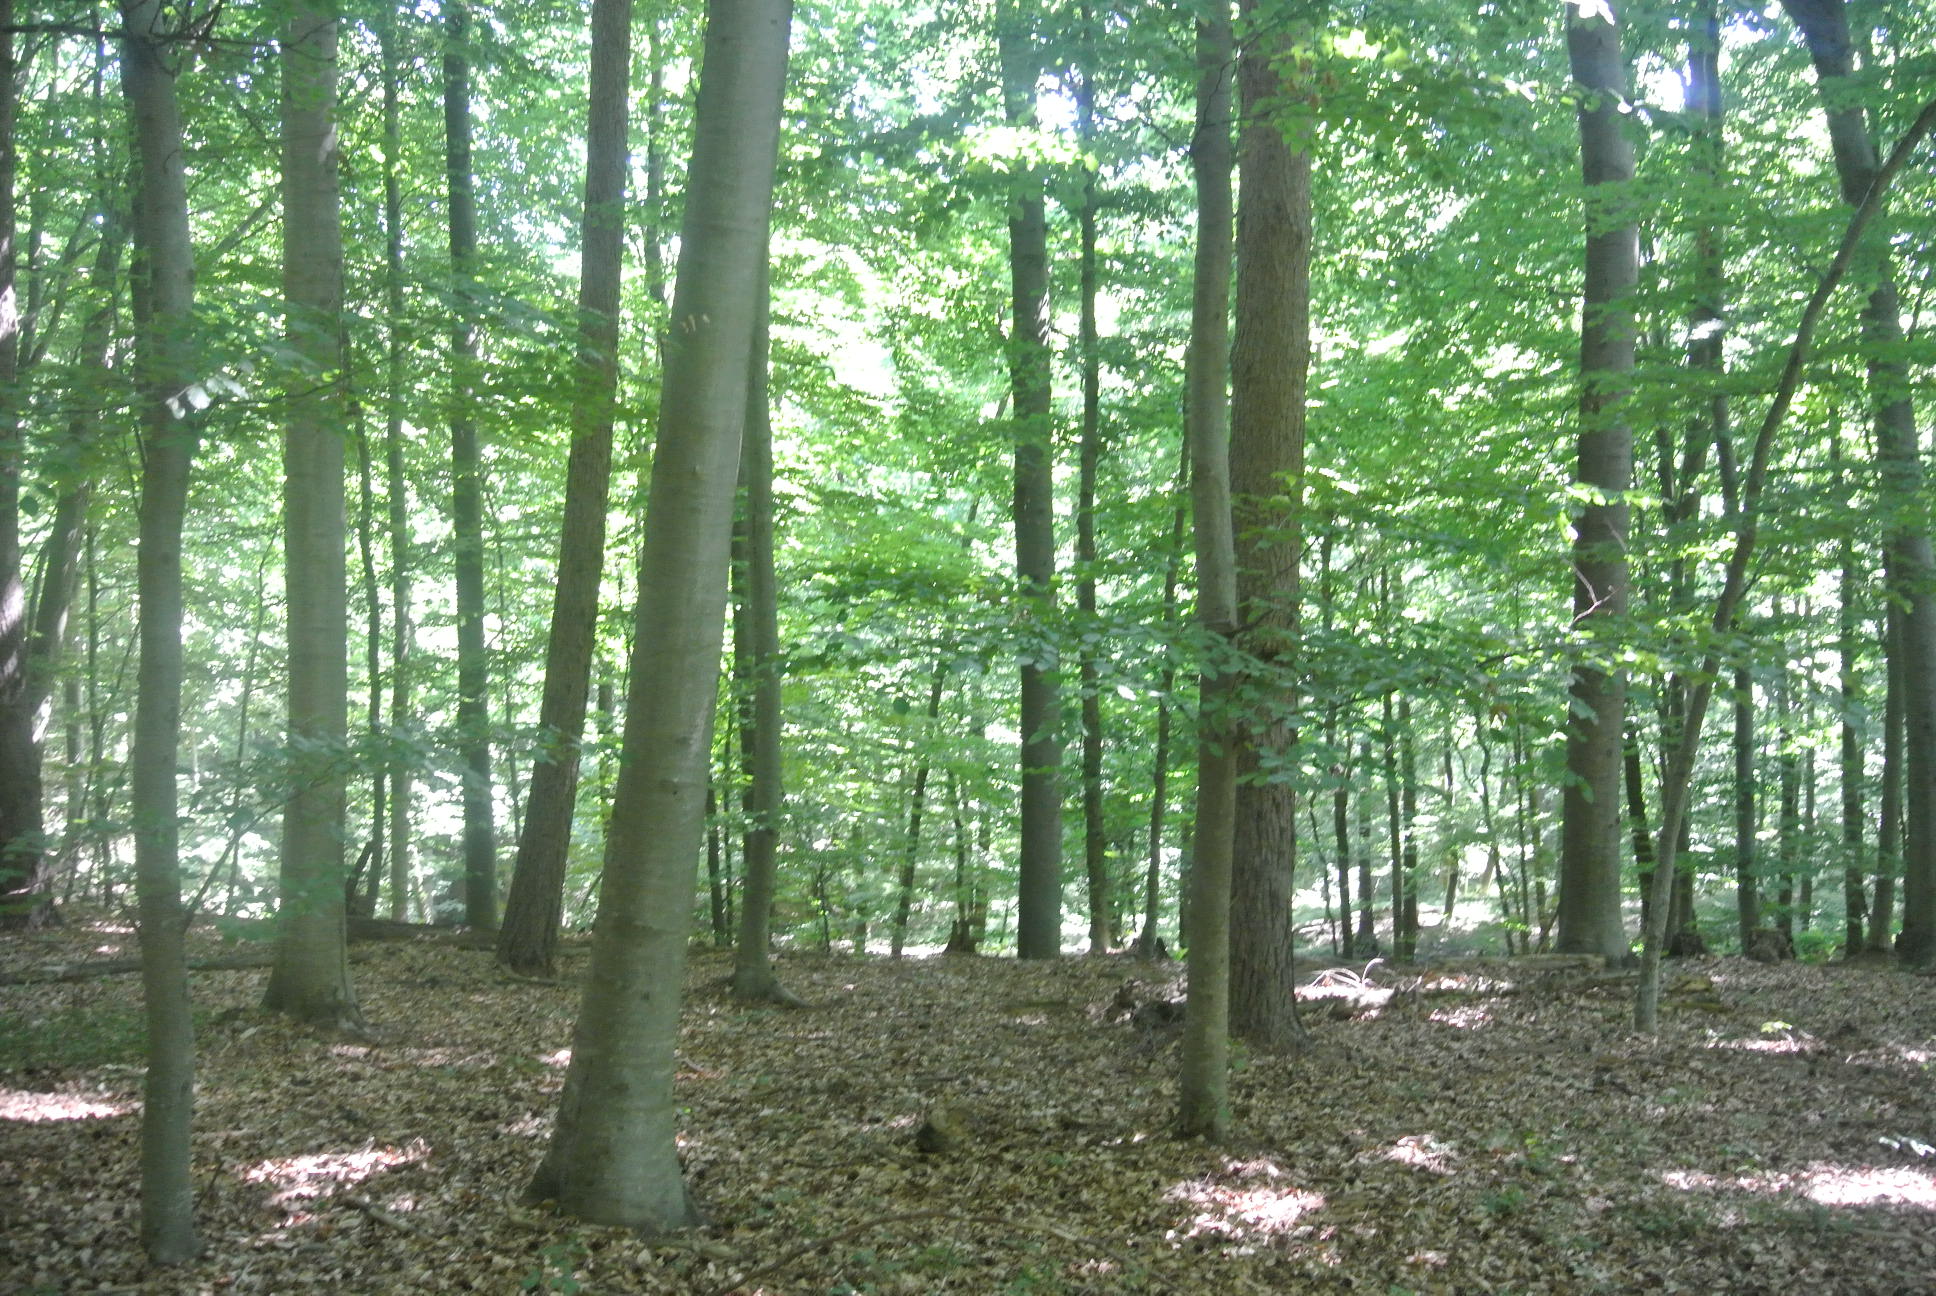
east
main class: Woodland
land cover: Broadleaved woodland
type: beech forest
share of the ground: > 75 %
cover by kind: broadleaved forest trees 100 %
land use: Forestry
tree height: > 5 m
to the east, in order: Broadleaved woodland; Rivers and streams; Broadleaved woodland; Tracks; Broadleaved woodland
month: July
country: AT
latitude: 47.6369
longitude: 16.4592
